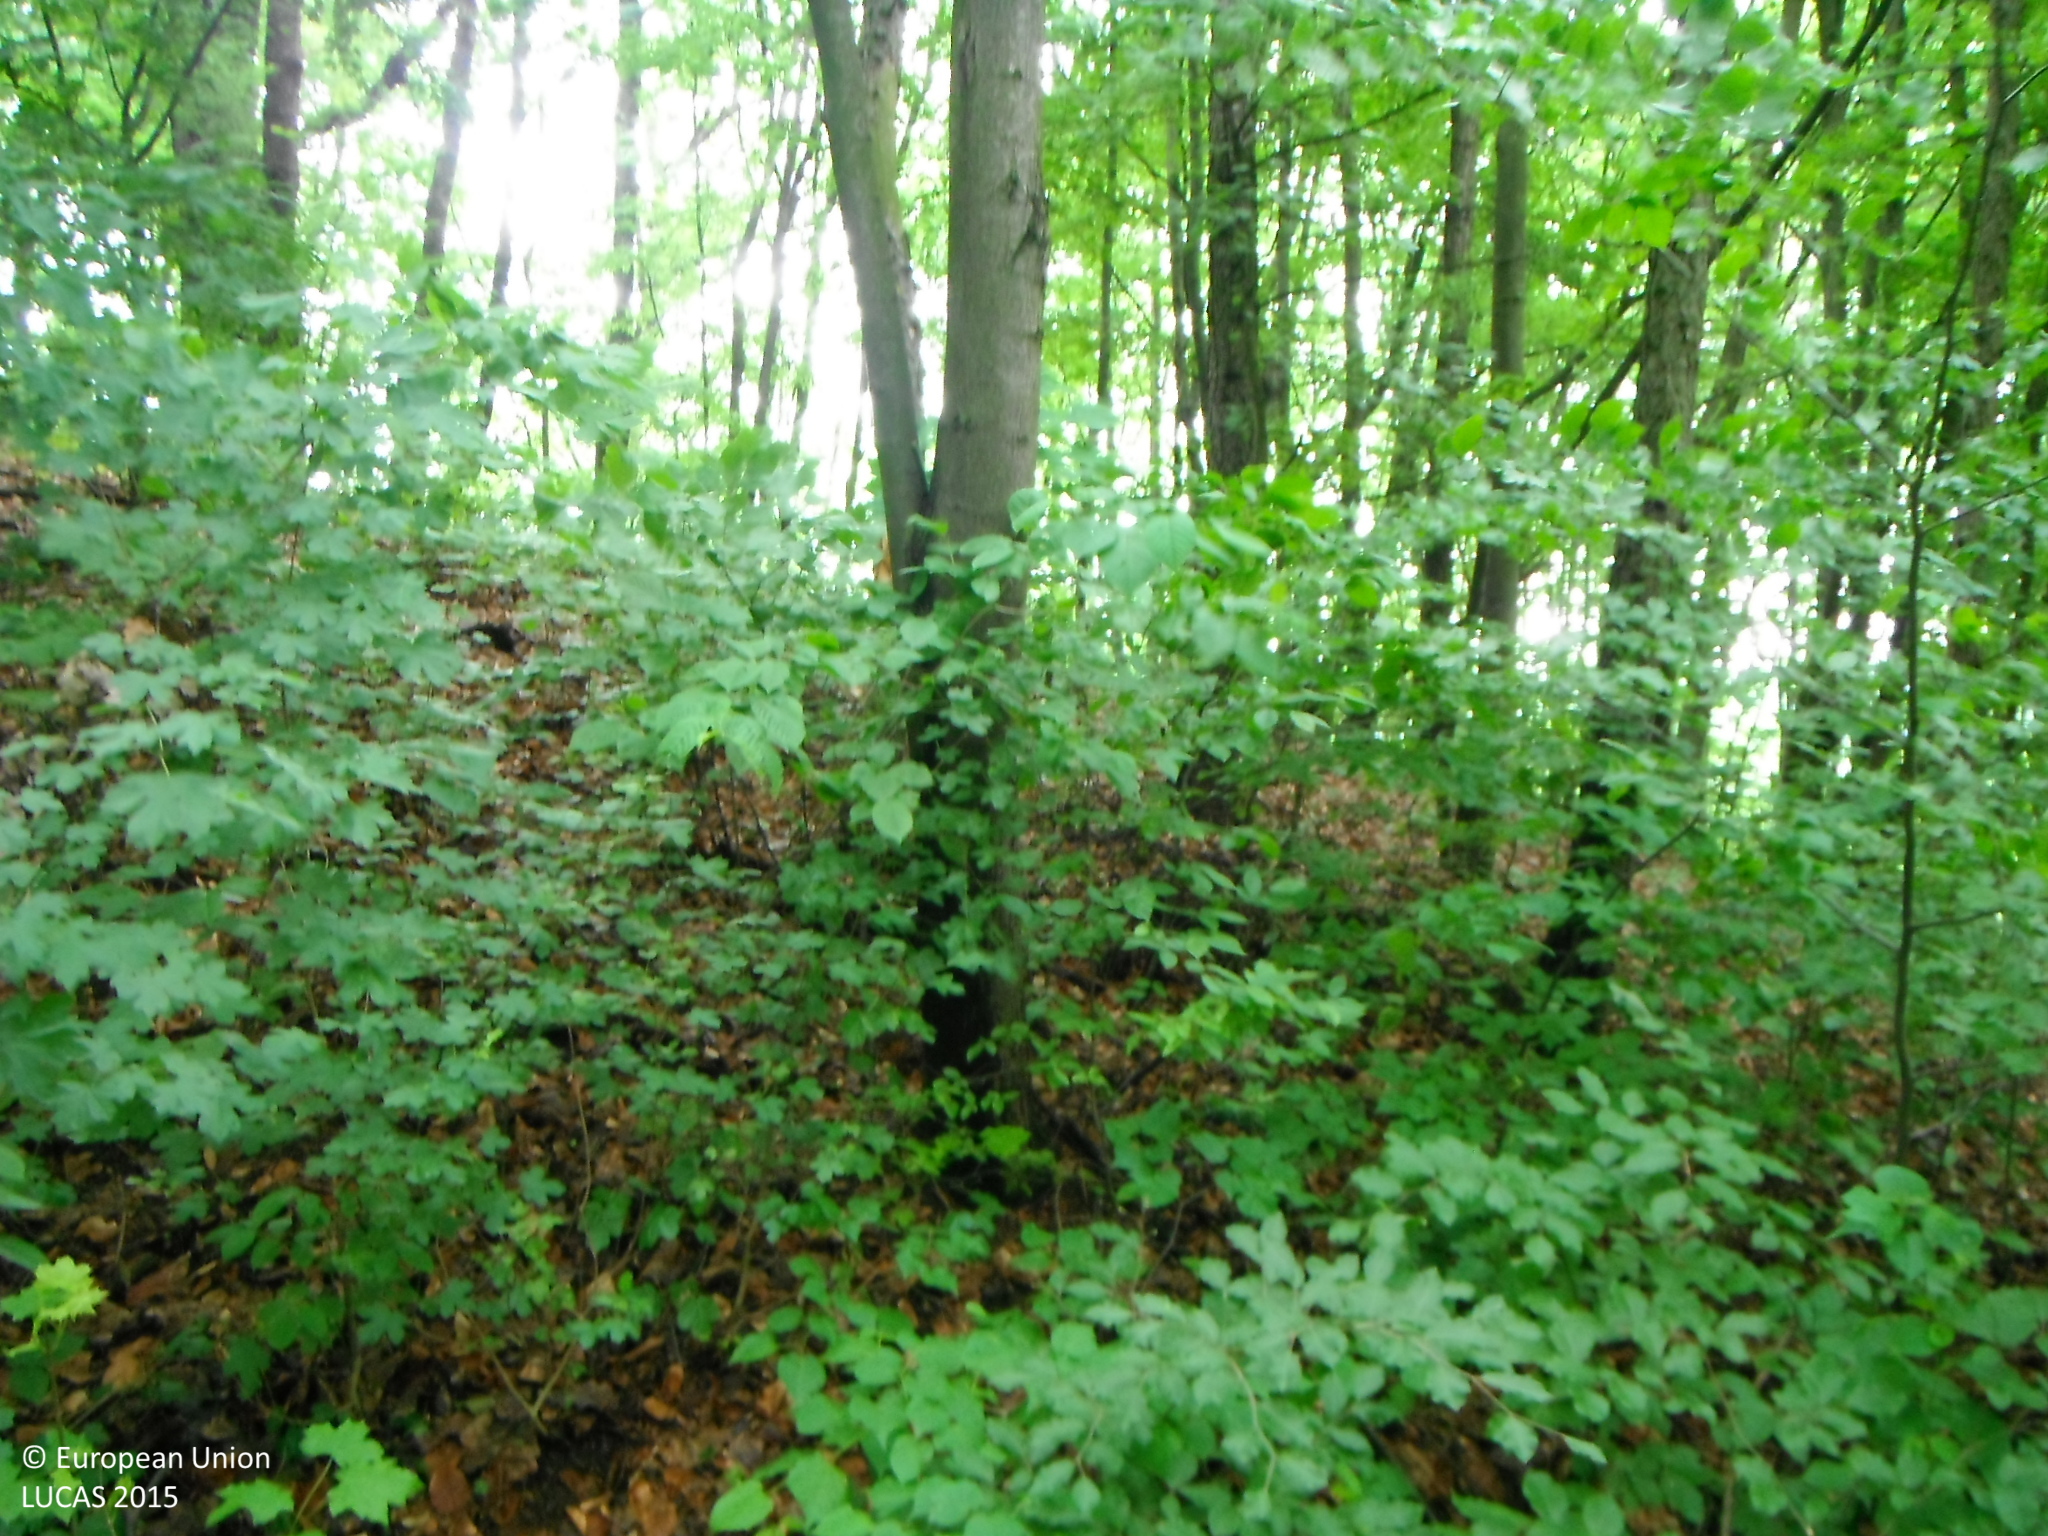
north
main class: Woodland
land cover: Other mixed woodland
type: hemiboreal forest and nemoral coniferous forest and mixed broadleaved-coniferous forest
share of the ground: > 75 %
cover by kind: broadleaved forest trees 60 %, coniferous forest trees 40 %
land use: Forestry
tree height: > 5 m
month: May
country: SK
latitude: 48.7300
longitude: 19.1448
